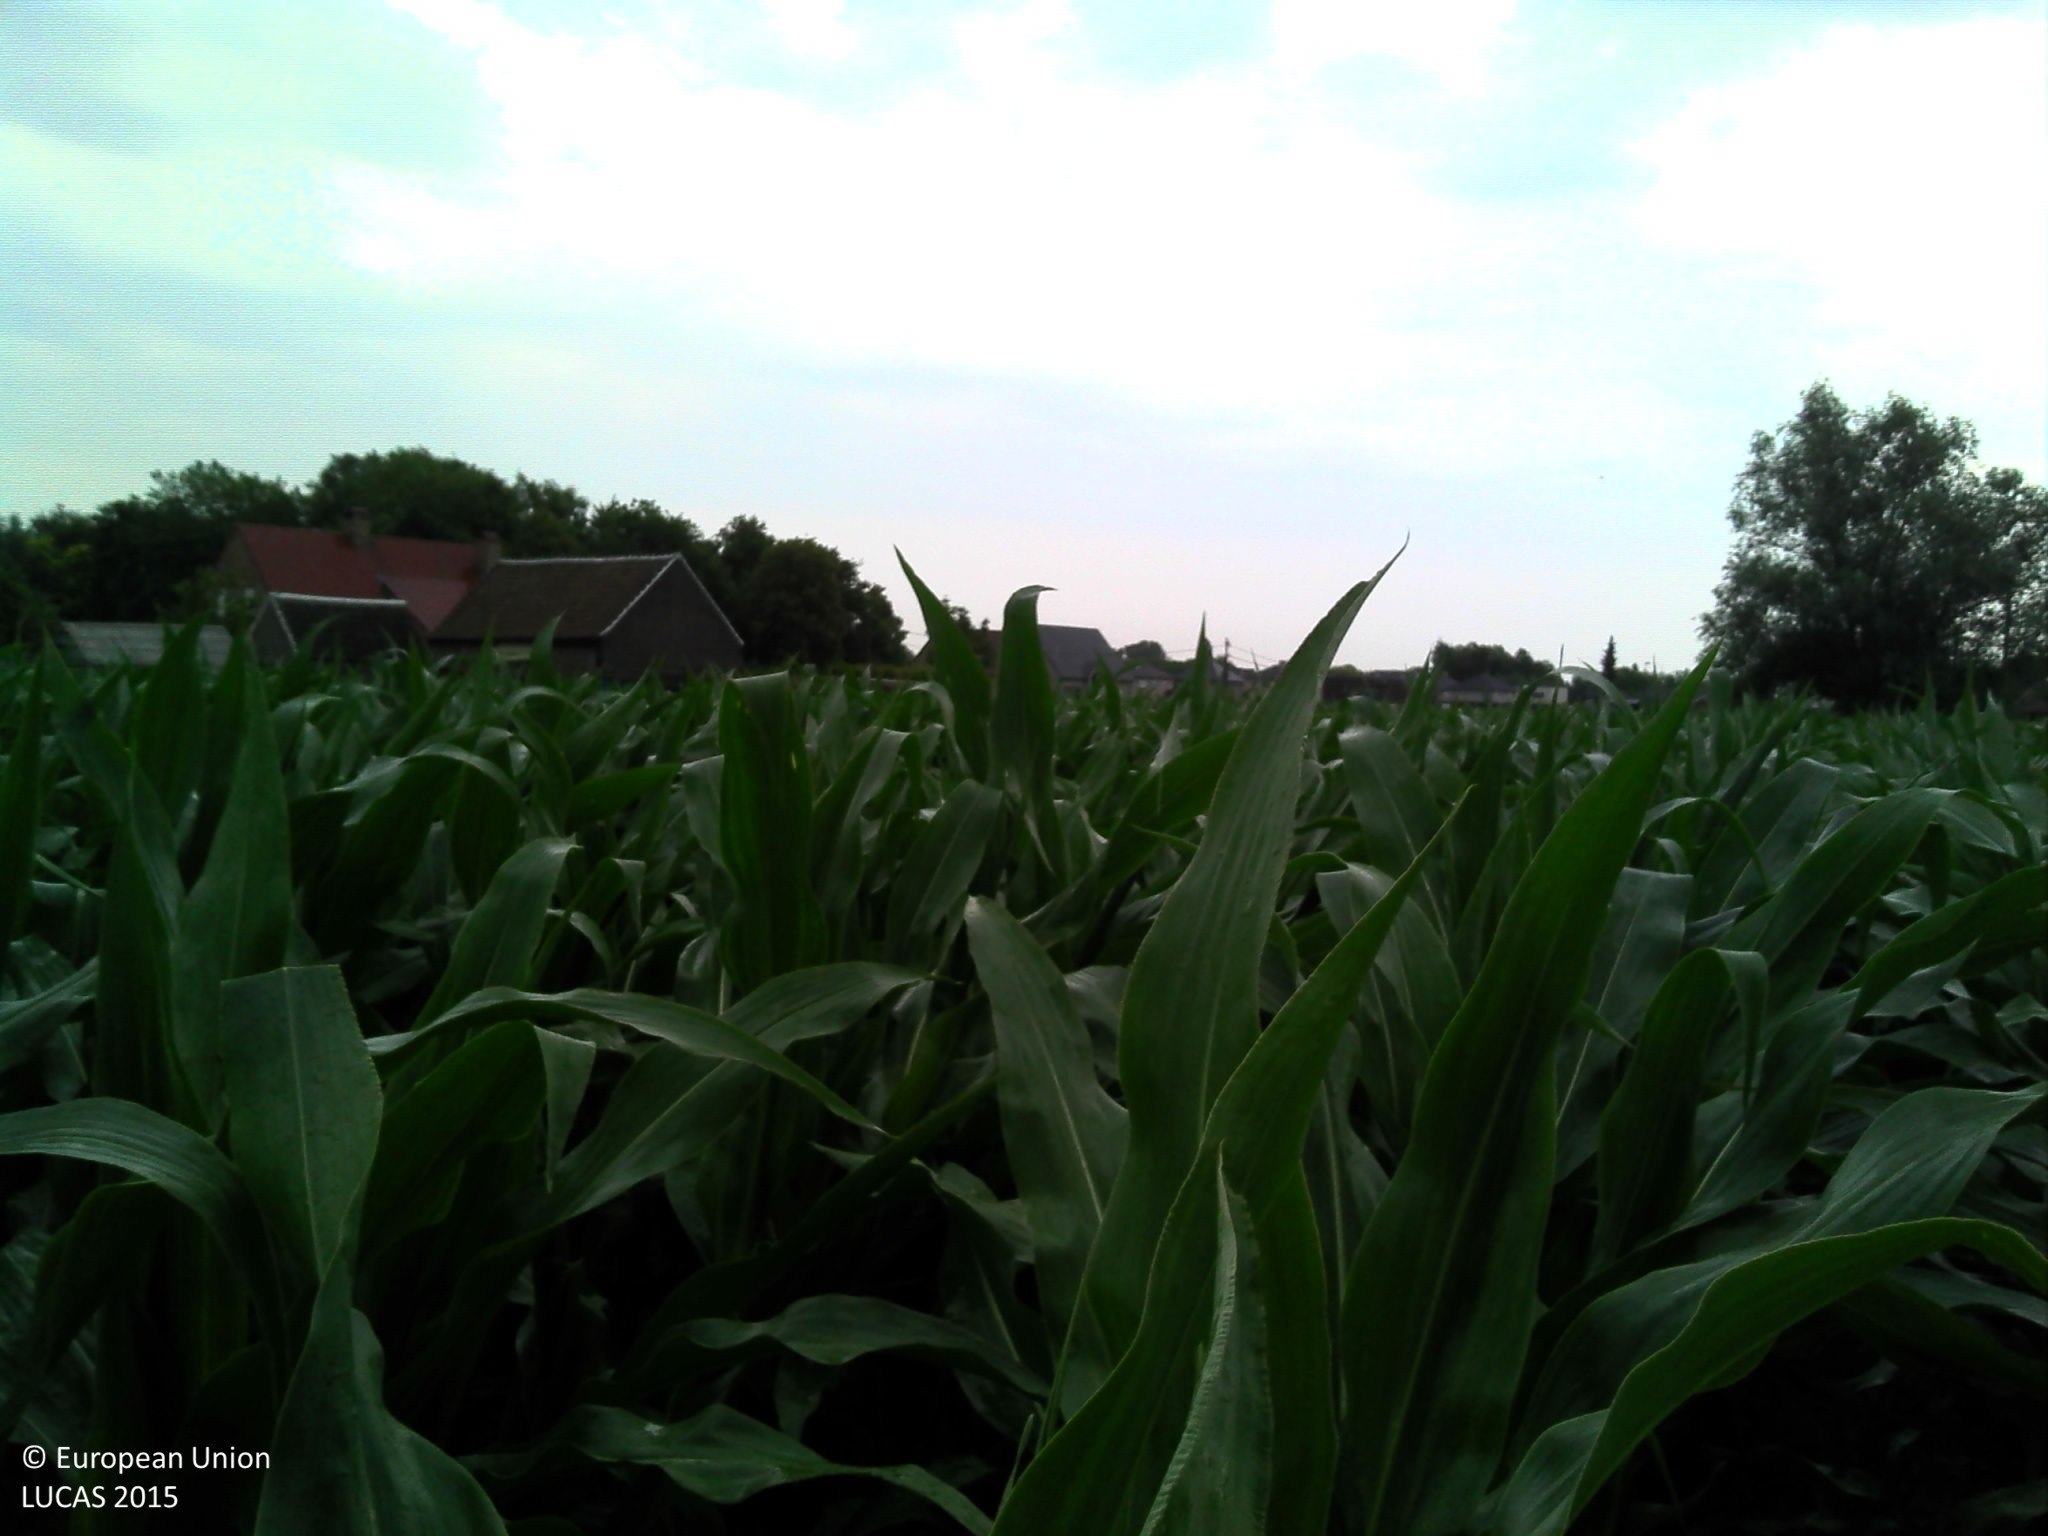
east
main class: Cropland
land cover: Maize
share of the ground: > 75 %
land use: Agriculture (excluding fallow land and kitchen gardens)
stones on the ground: < 10 %
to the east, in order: Maize; Grass margins; Ditches and canals; Grass margins; Maize; Fences; Grassland without tree/shrub cover; Fences; Ditches and canals; Grass margins; Paved roads, cycling and walking lanes; Managed hedges; Grass margins; Fences; Maize; Ditches and canals; Maize
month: July
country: BE
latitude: 51.2484
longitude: 3.5886
